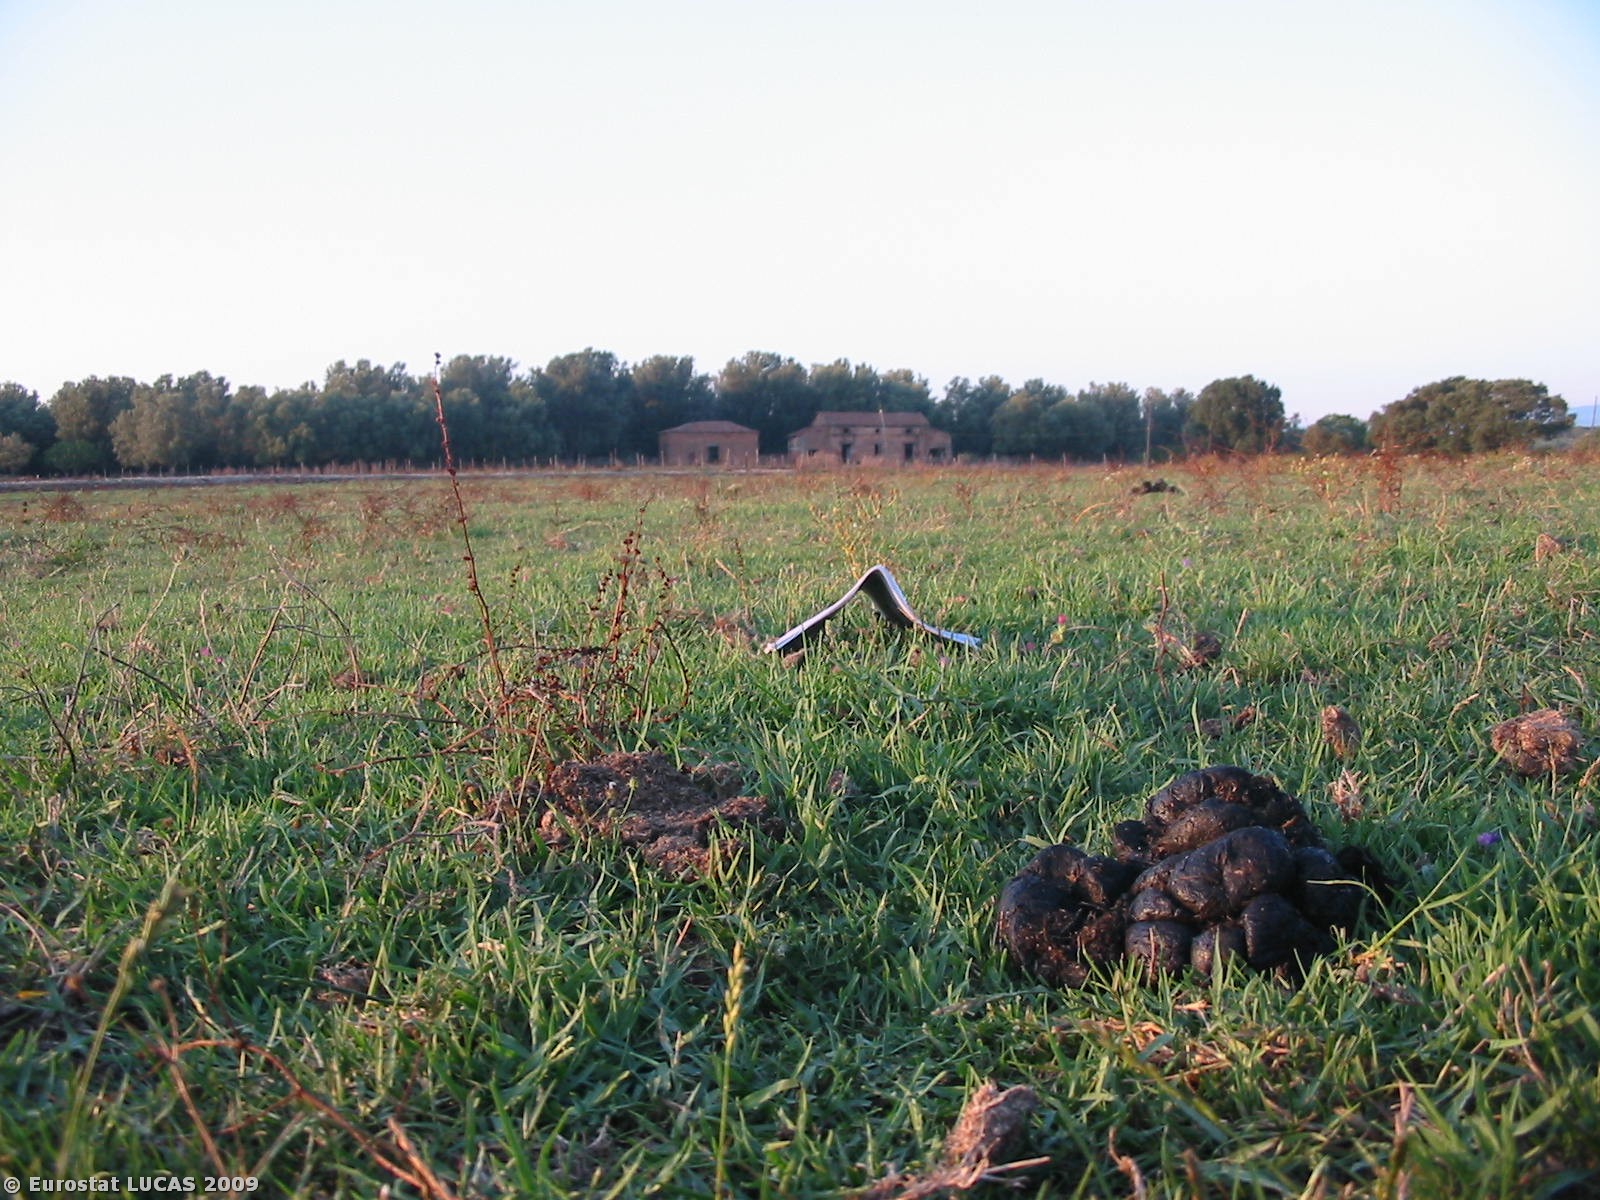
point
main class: Grassland
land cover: Grassland without tree/shrub cover
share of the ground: > 75 %
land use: Agriculture (excluding fallow land and kitchen gardens)
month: July
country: IT
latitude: 38.3975
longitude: 15.9532
